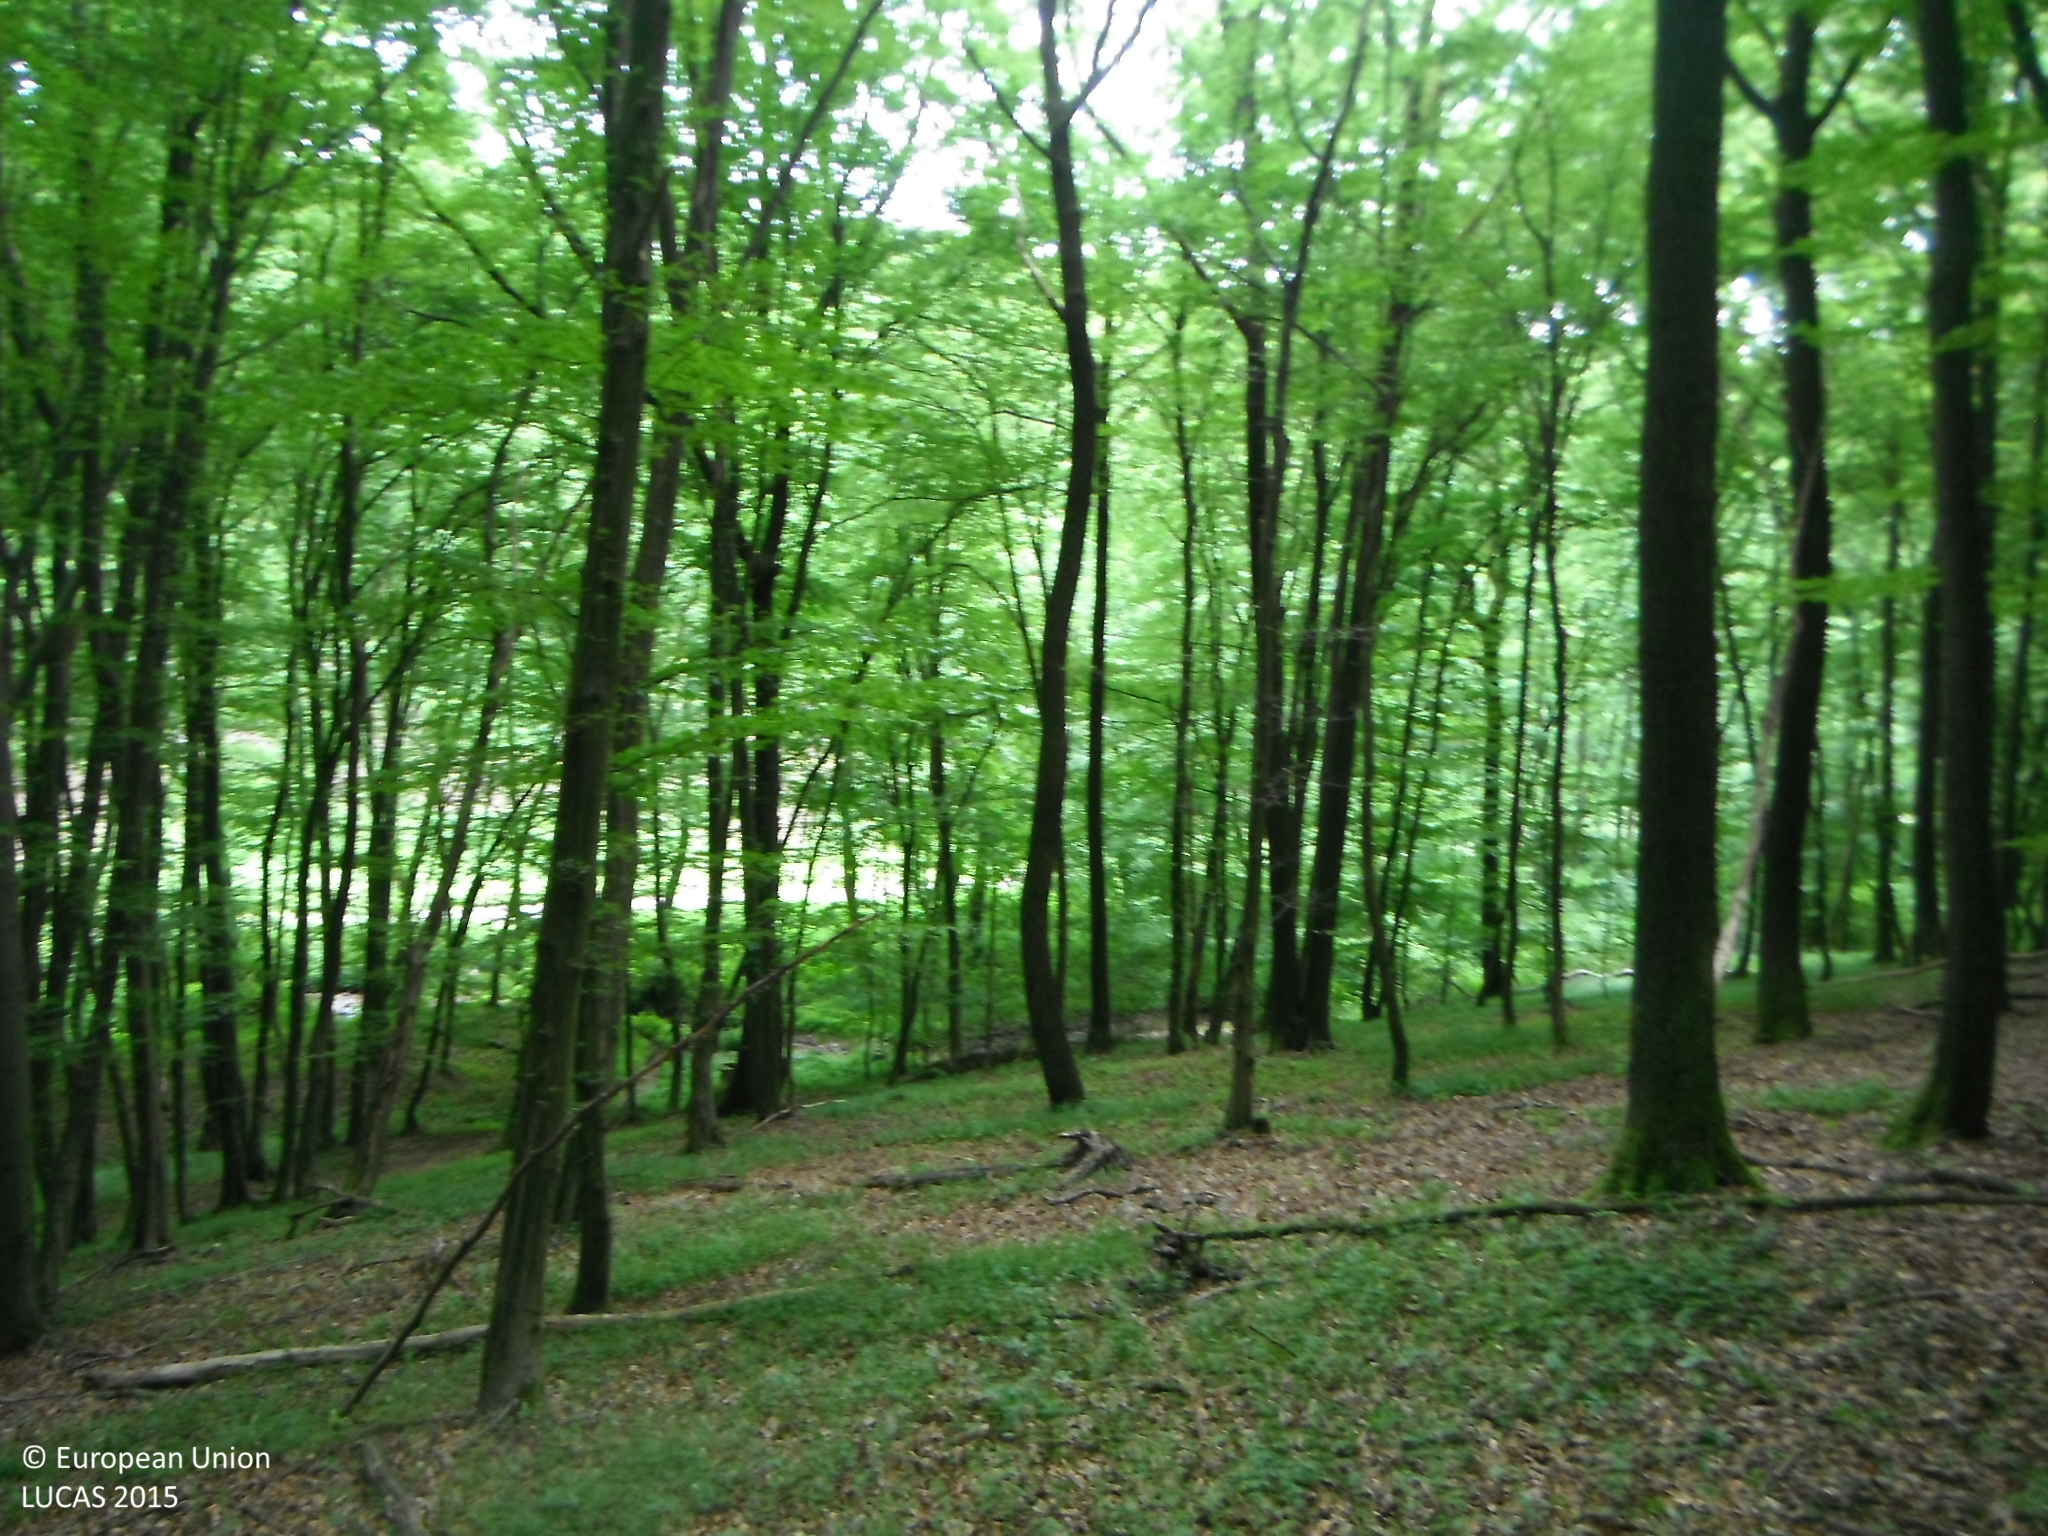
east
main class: Woodland
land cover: Broadleaved woodland
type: mesophytic deciduous forest
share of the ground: > 75 %
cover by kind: broadleaved forest trees 100 %
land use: Forestry
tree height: > 5 m
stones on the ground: < 10 %
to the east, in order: Broadleaved woodland; Rivers and streams; Broadleaved woodland; Tracks; Broadleaved woodland; Tracks; Broadleaved woodland; Shrubland with sparse tree cover; Pine dominated mixed woodland; Broadleaved woodland
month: June
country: SK
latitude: 48.4704
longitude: 18.3068
